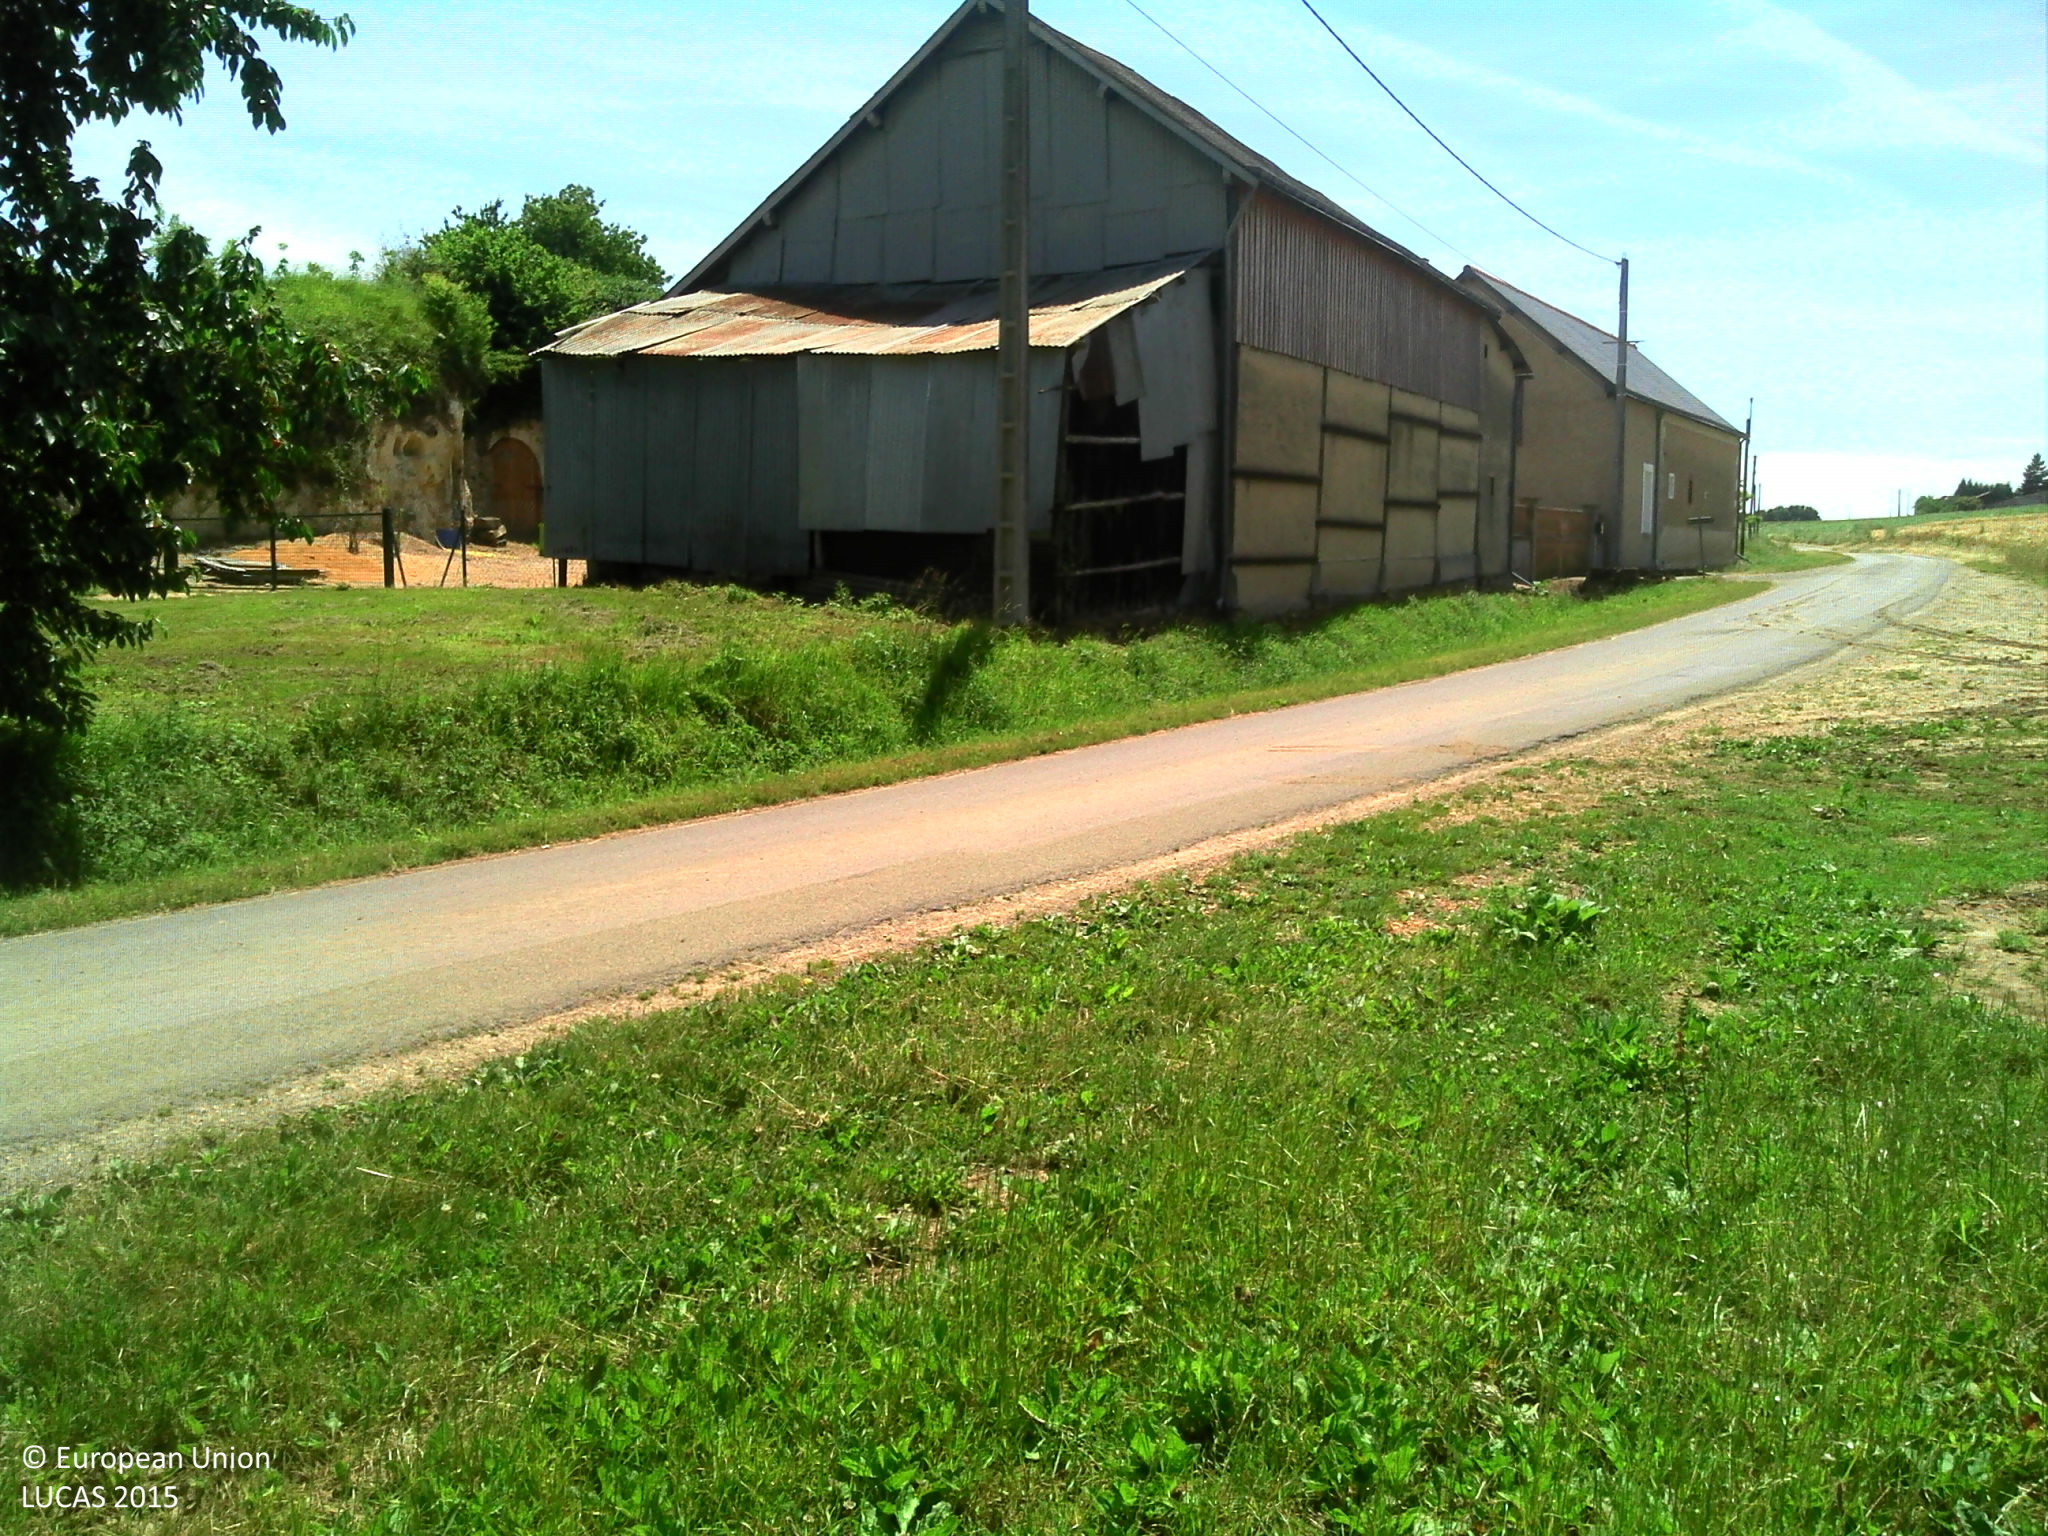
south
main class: Grassland
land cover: Spontaneously vegetated surfaces
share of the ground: 50 - 75 %
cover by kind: herbaceous plants 75 %, consolidated bare surface 25 %
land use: Construction
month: June
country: FR
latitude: 47.6280
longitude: 0.4629
